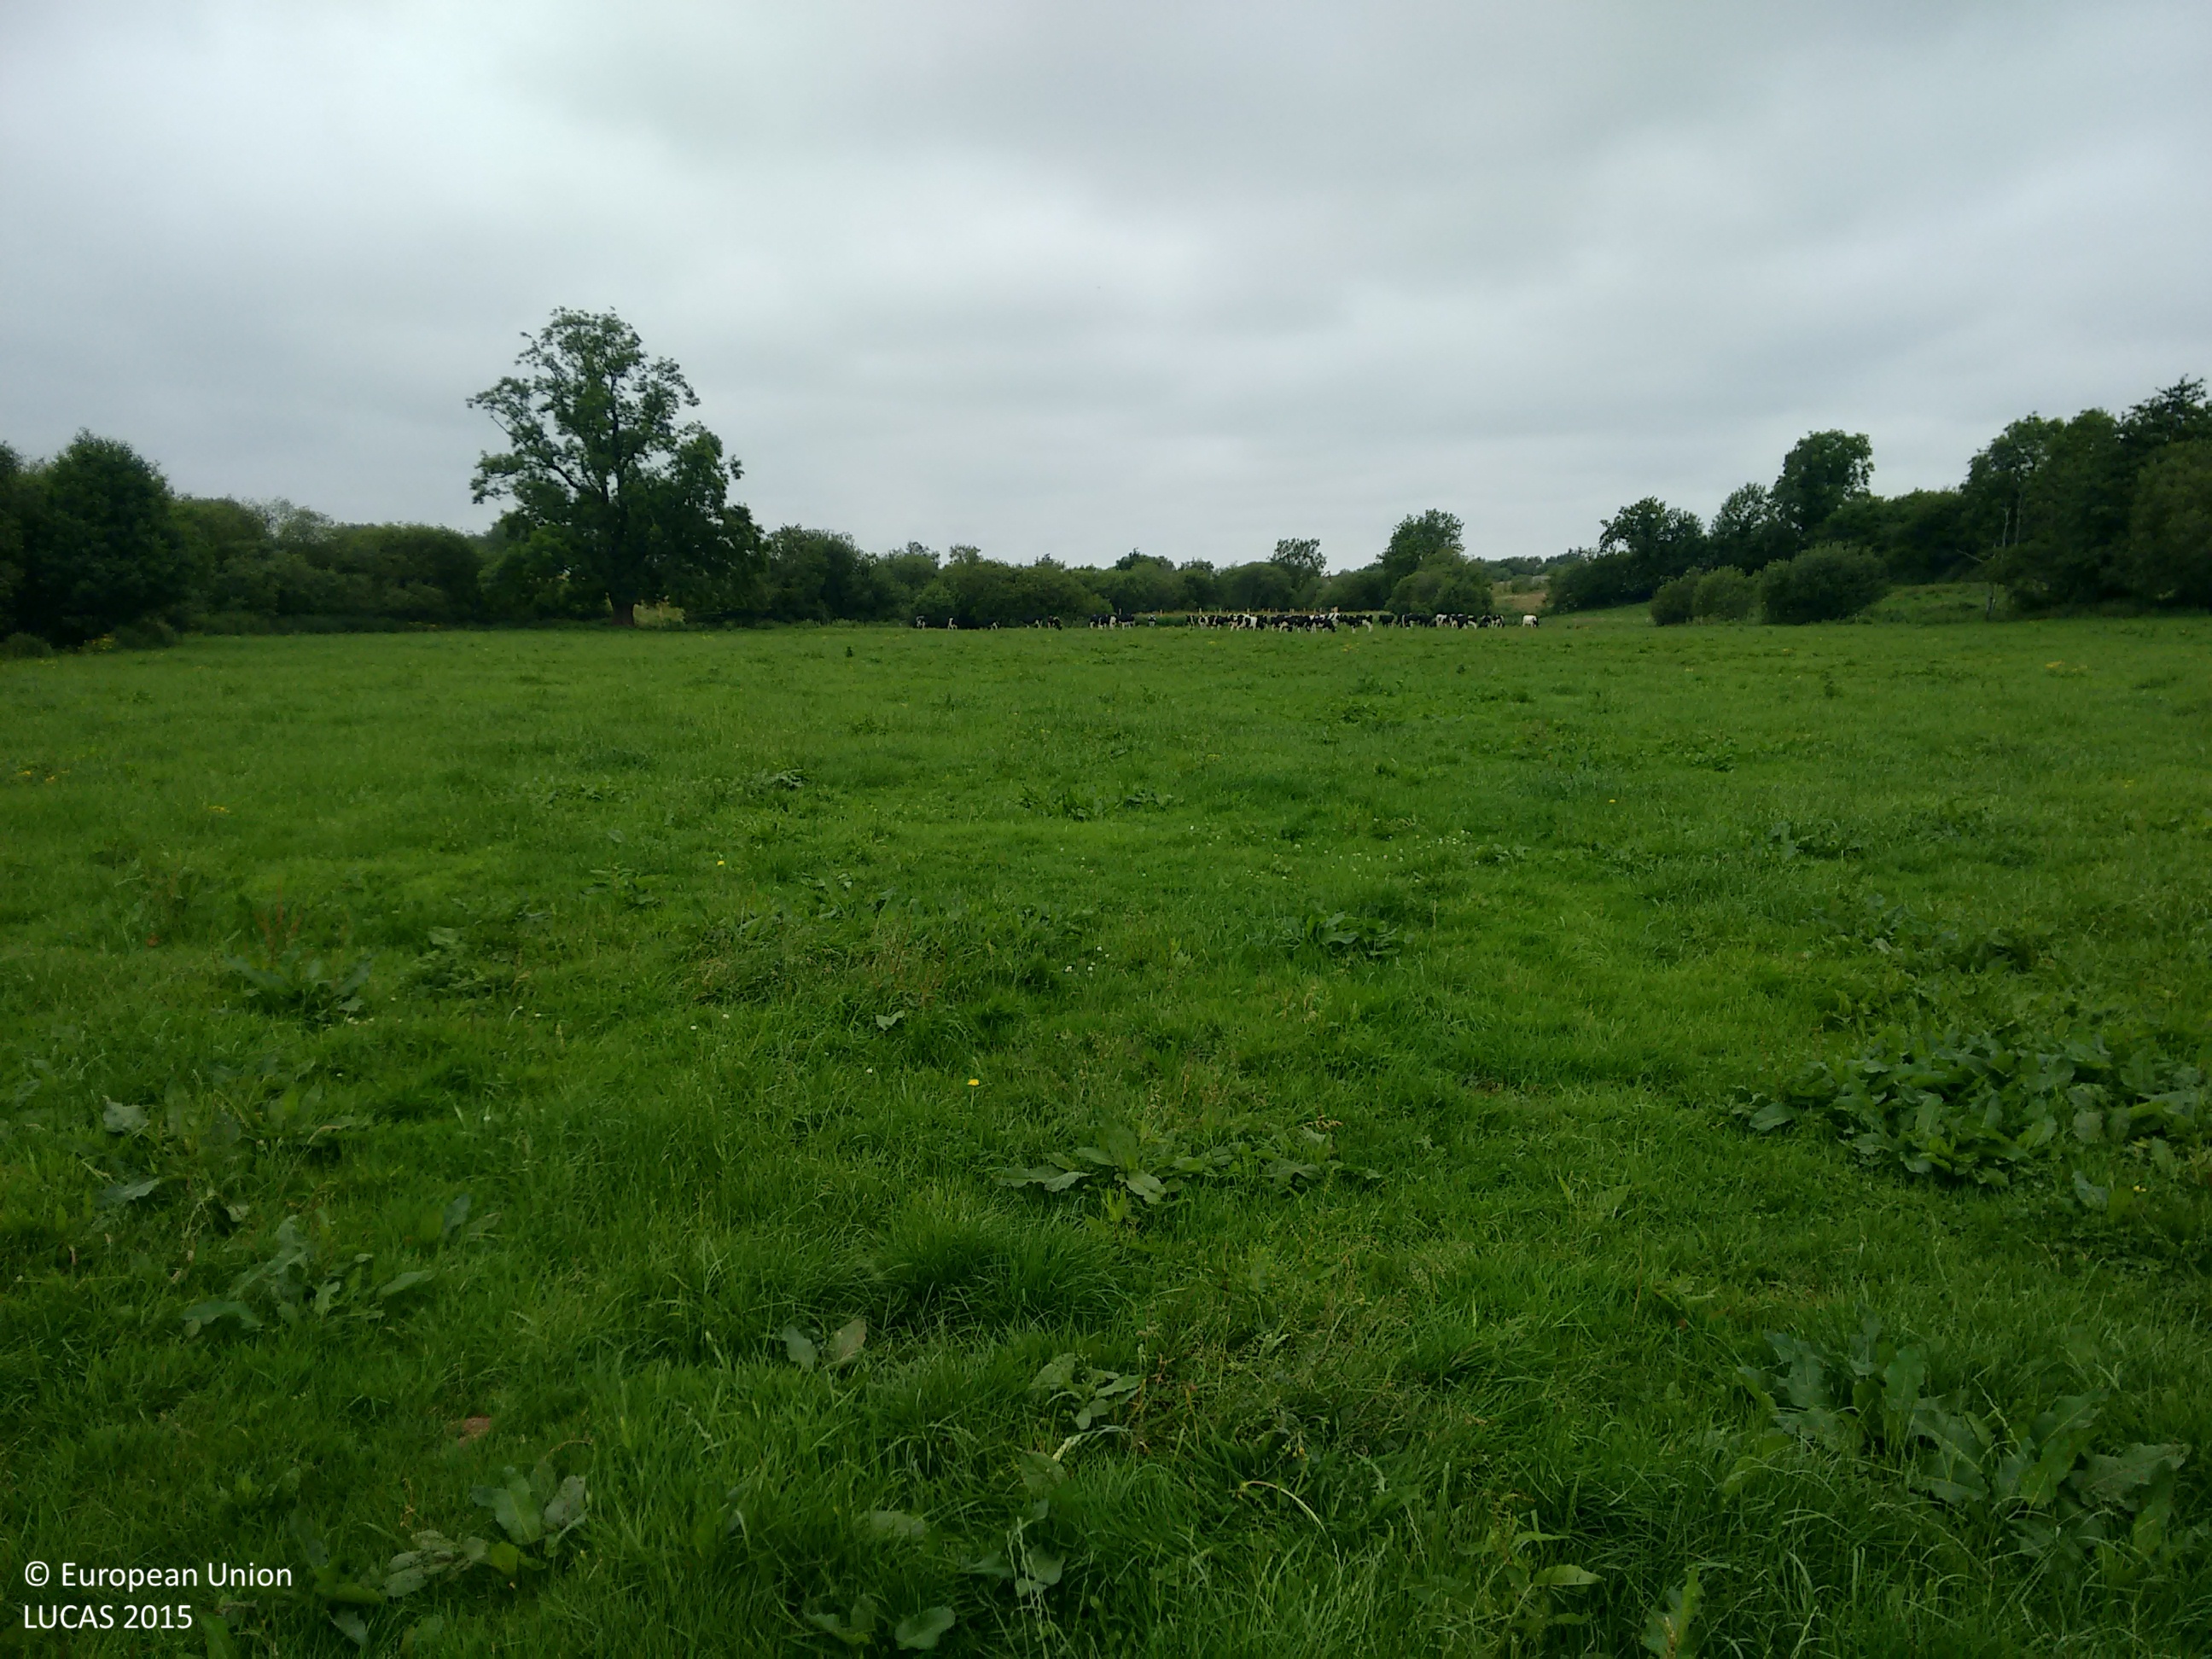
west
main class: Grassland
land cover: Grassland without tree/shrub cover
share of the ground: > 75 %
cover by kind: herbaceous plants 100 %
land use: Agriculture (excluding fallow land and kitchen gardens)
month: July
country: IE
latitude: 52.4783
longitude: -7.5187
